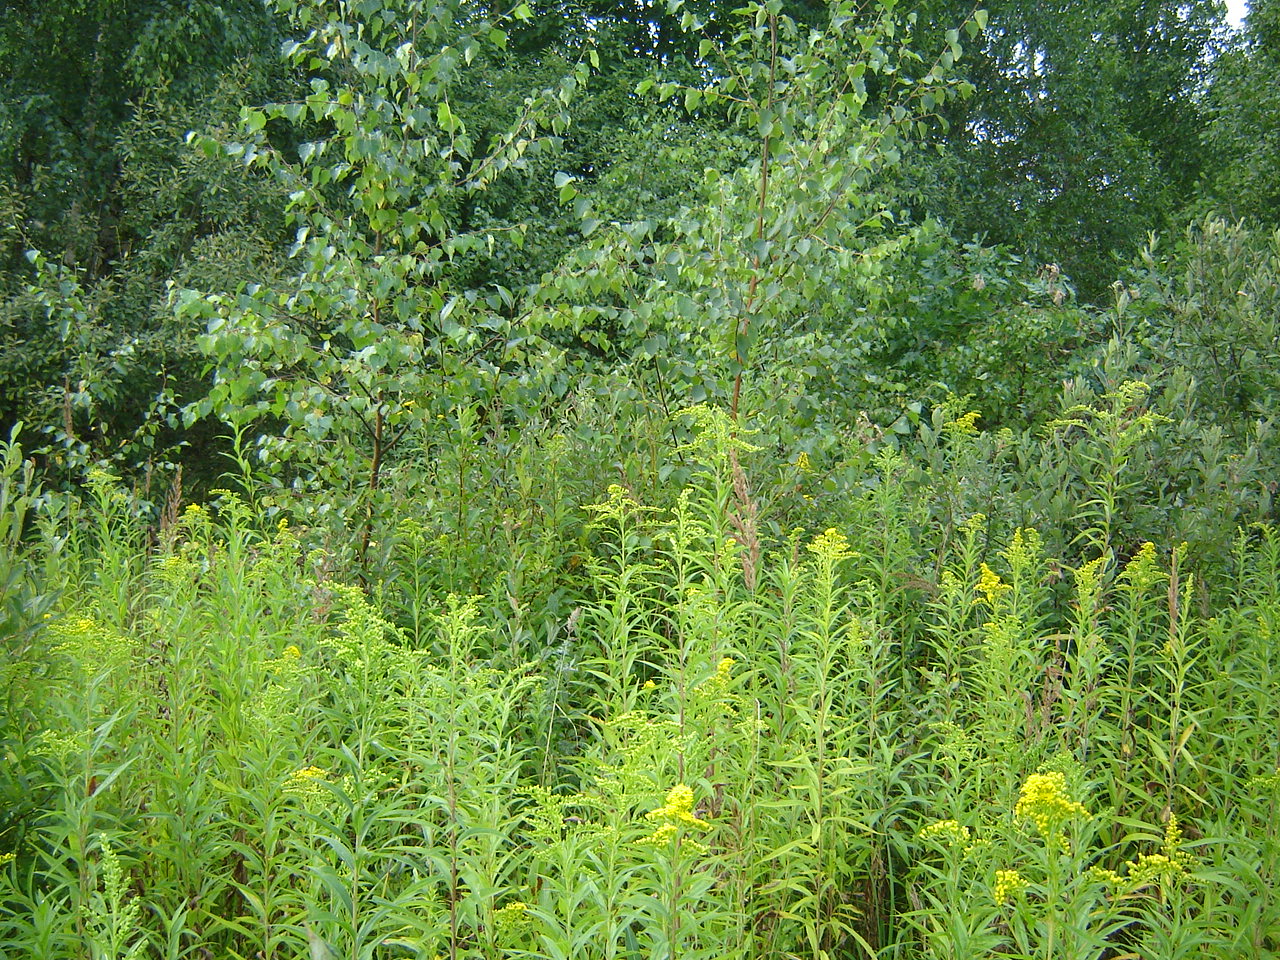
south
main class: Woodland
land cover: Broadleaved woodland
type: non-riverine alder, birch or aspen forest
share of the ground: > 75 %
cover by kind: broadleaved forest trees 90 %, coniferous forest trees 10 %
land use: Forestry
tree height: < 5 m
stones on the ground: < 10 %
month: August
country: LT
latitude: 54.9625
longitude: 24.9018
